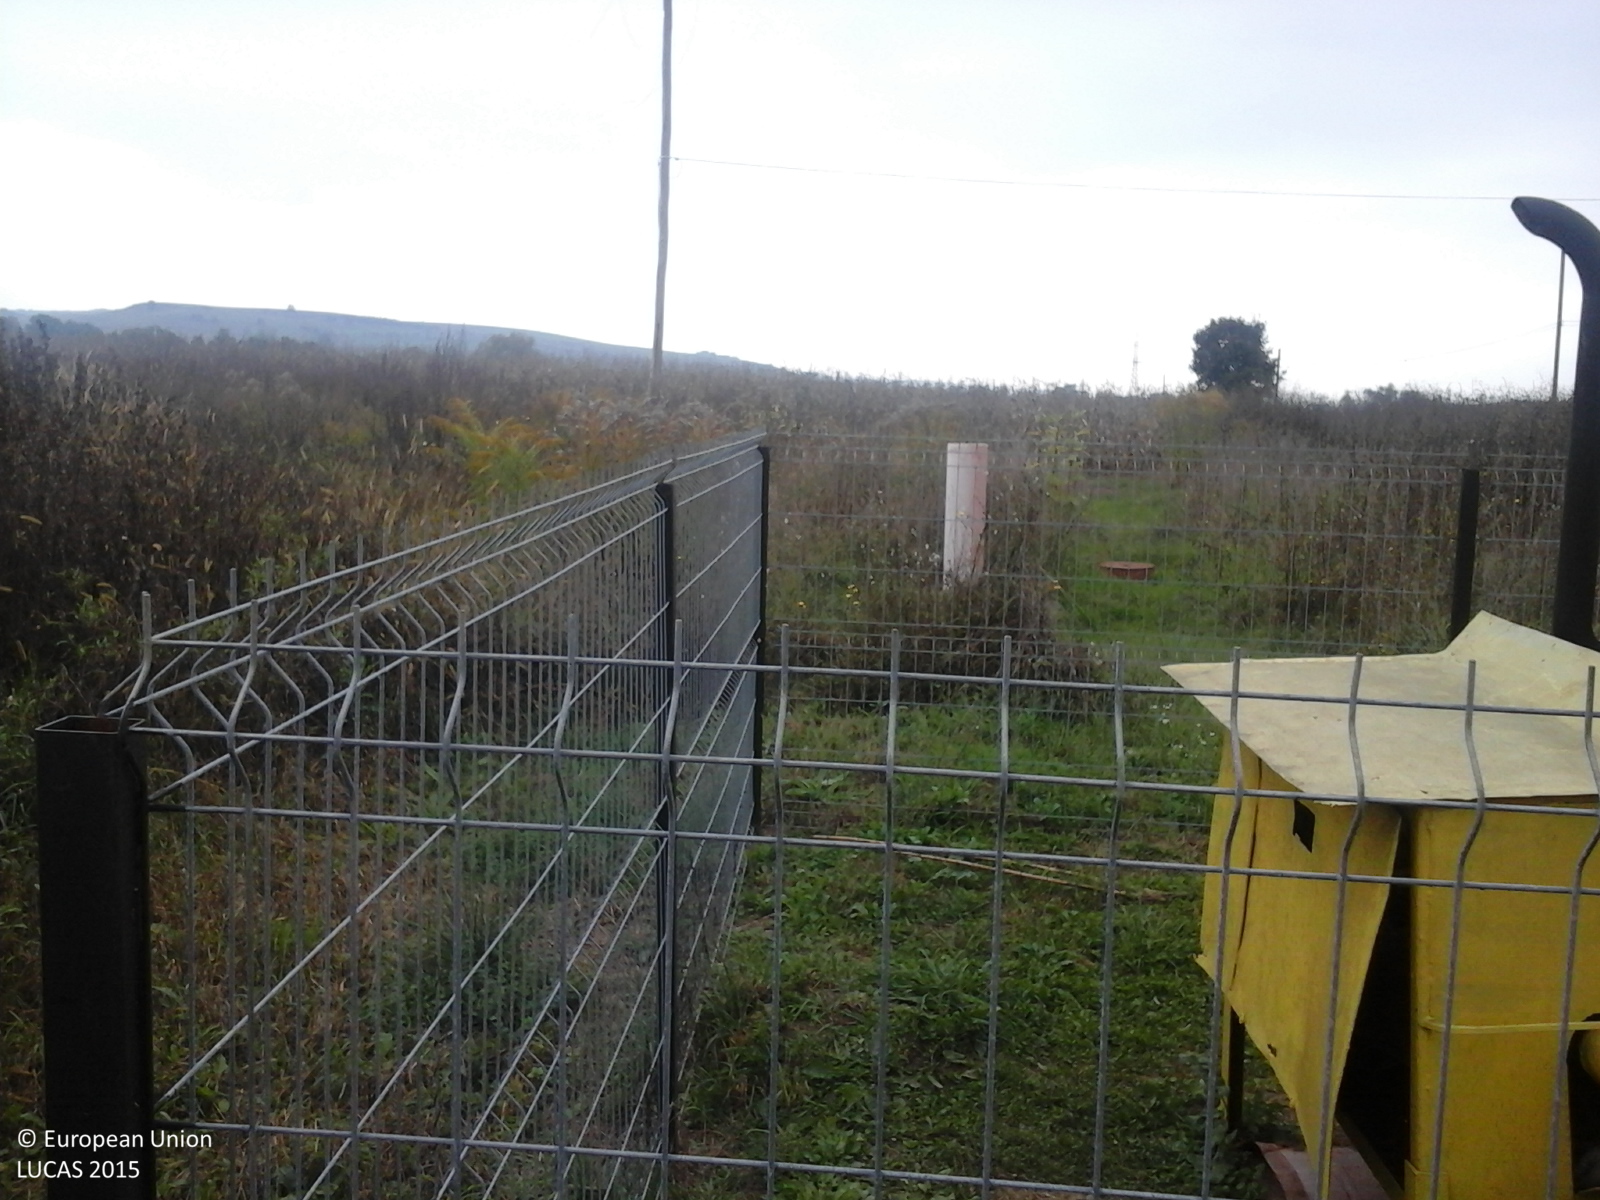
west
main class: Cropland
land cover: Maize
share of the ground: > 75 %
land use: Agriculture (excluding fallow land and kitchen gardens)
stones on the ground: < 10 %
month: October
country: RO
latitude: 46.2216
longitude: 24.7262
